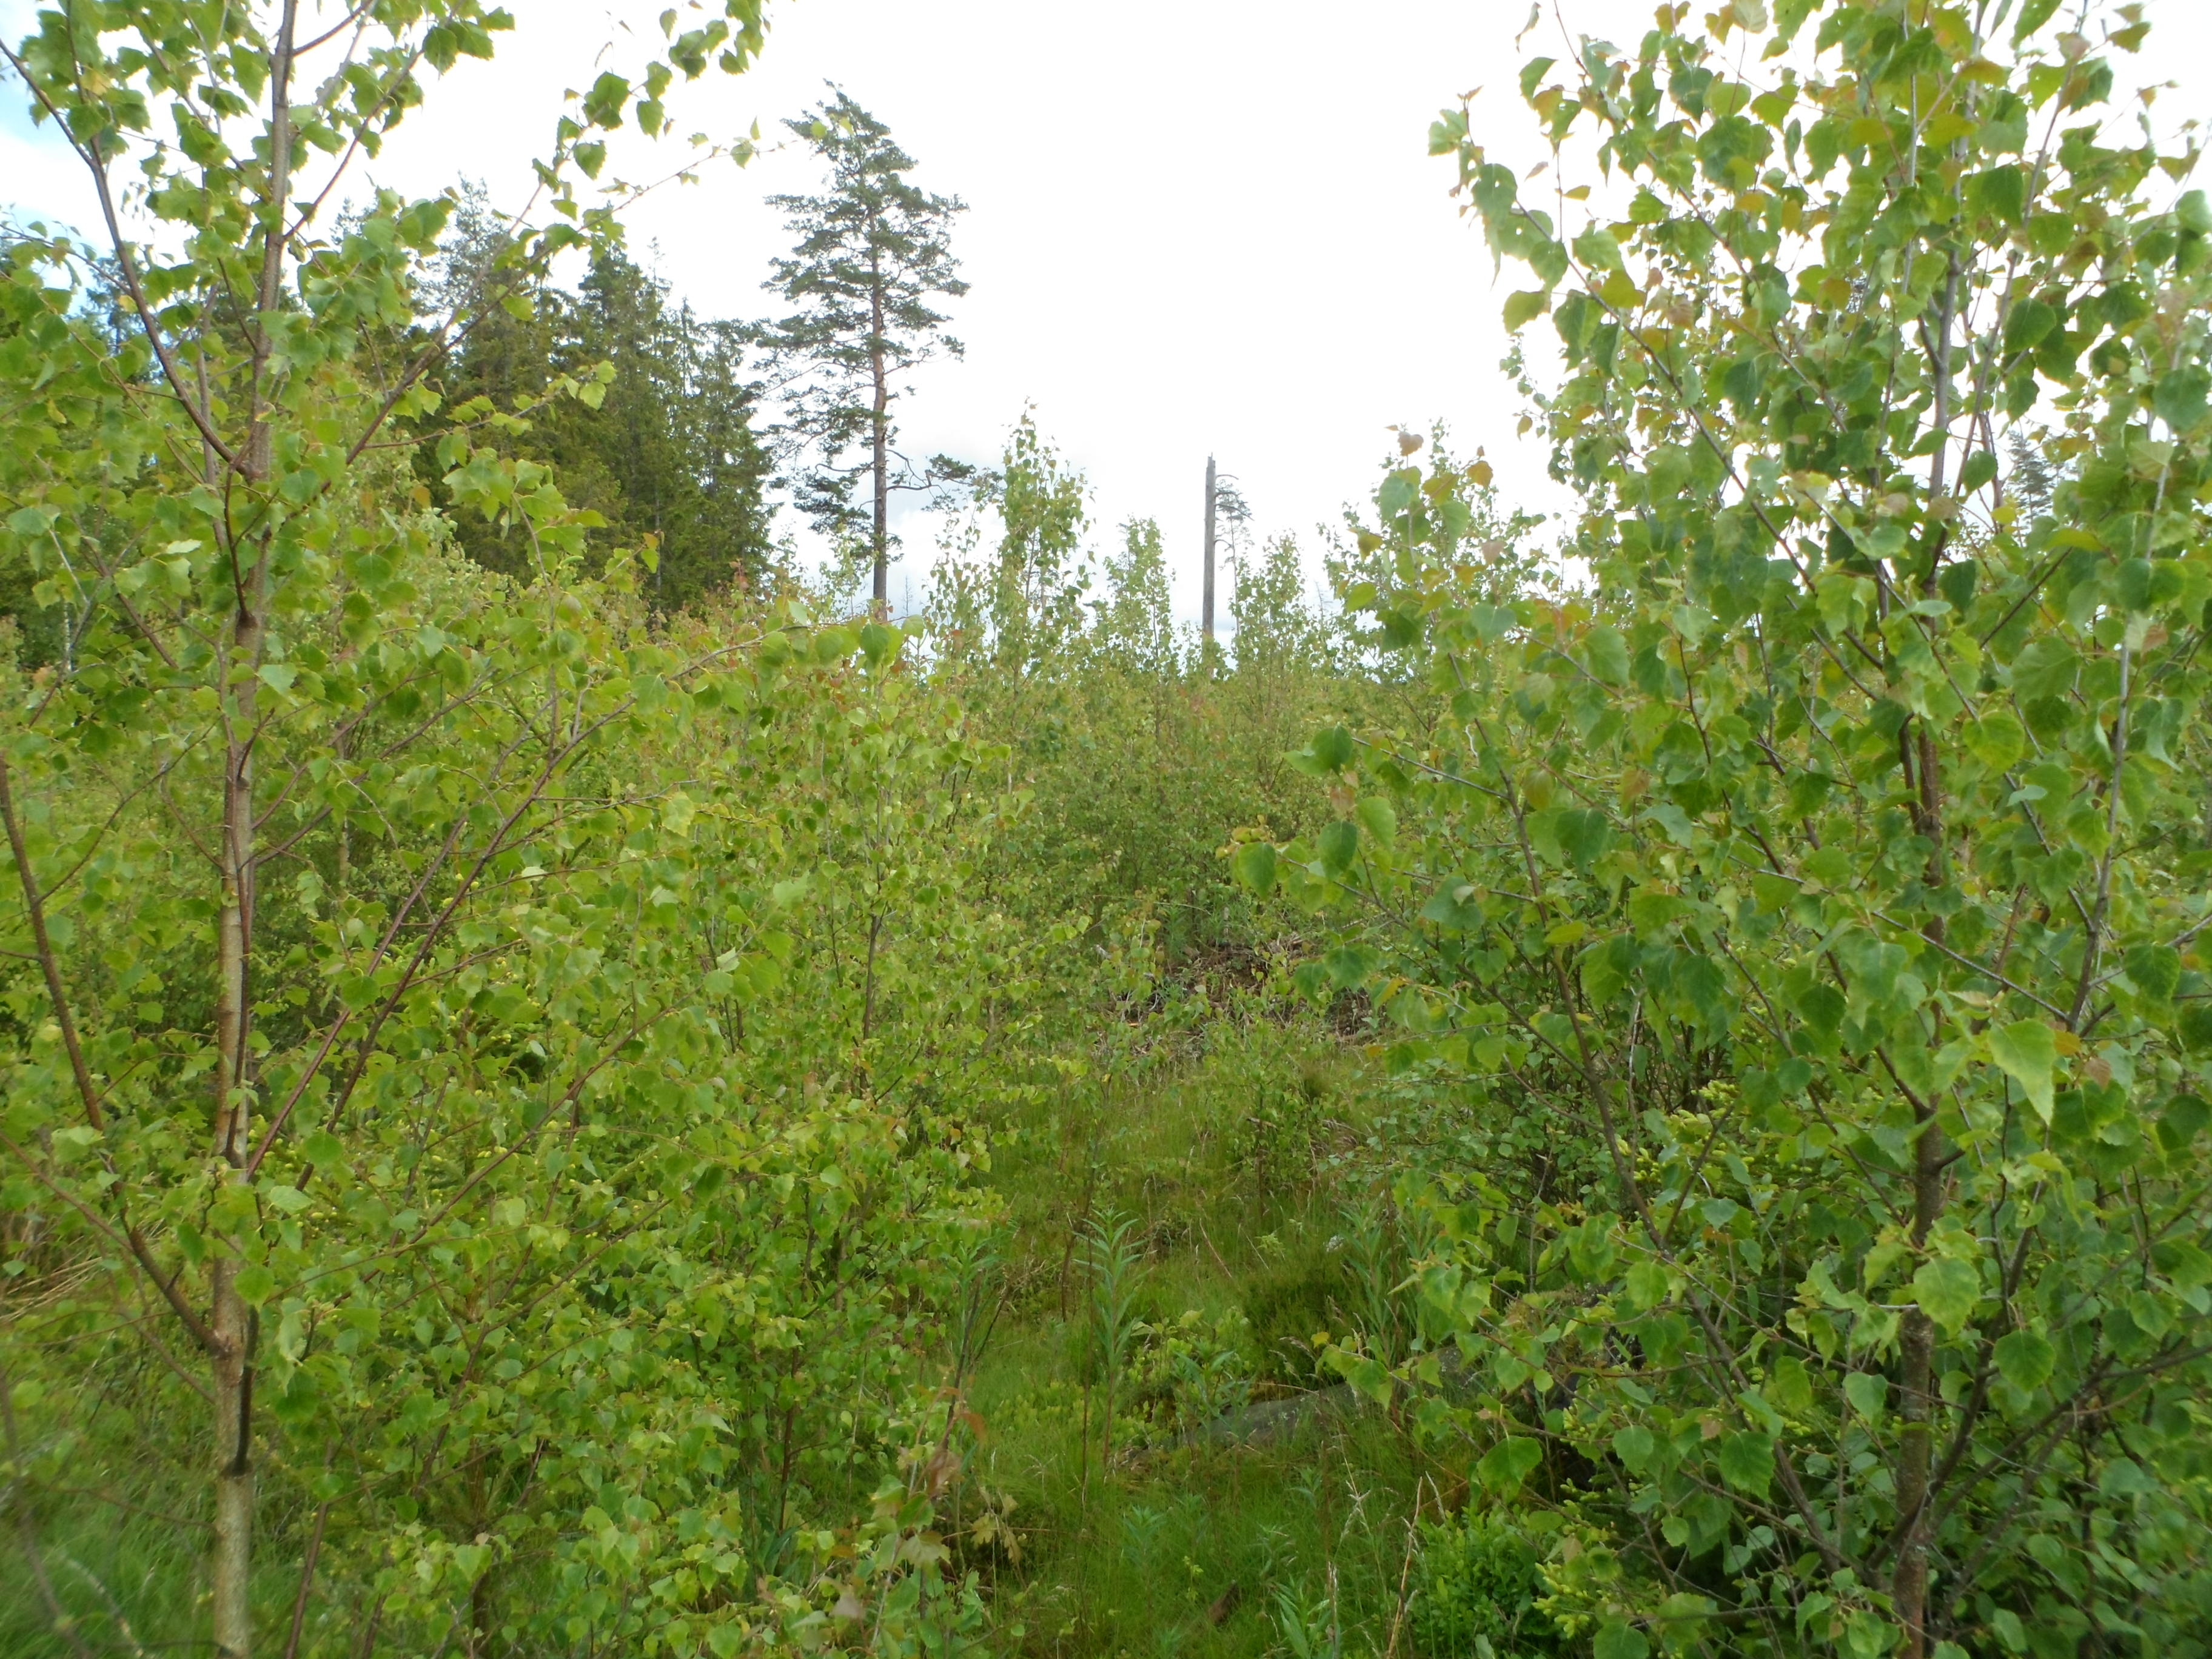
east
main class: Woodland
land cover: Spruce dominated mixed woodland
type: boreal forest
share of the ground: > 75 %
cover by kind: broadleaved forest trees 45 %, coniferous forest trees 35 %, shrubs 10 %, herbaceous plants 10 %
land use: Forestry
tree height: > 5 m
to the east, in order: Spruce dominated mixed woodland; Tracks; Spruce dominated mixed woodland; Spruce dominated coniferous woodland; Spruce dominated mixed woodland; Broadleaved woodland; Shrubland with sparse tree cover
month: June
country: SE
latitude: 57.0096
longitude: 14.4921
